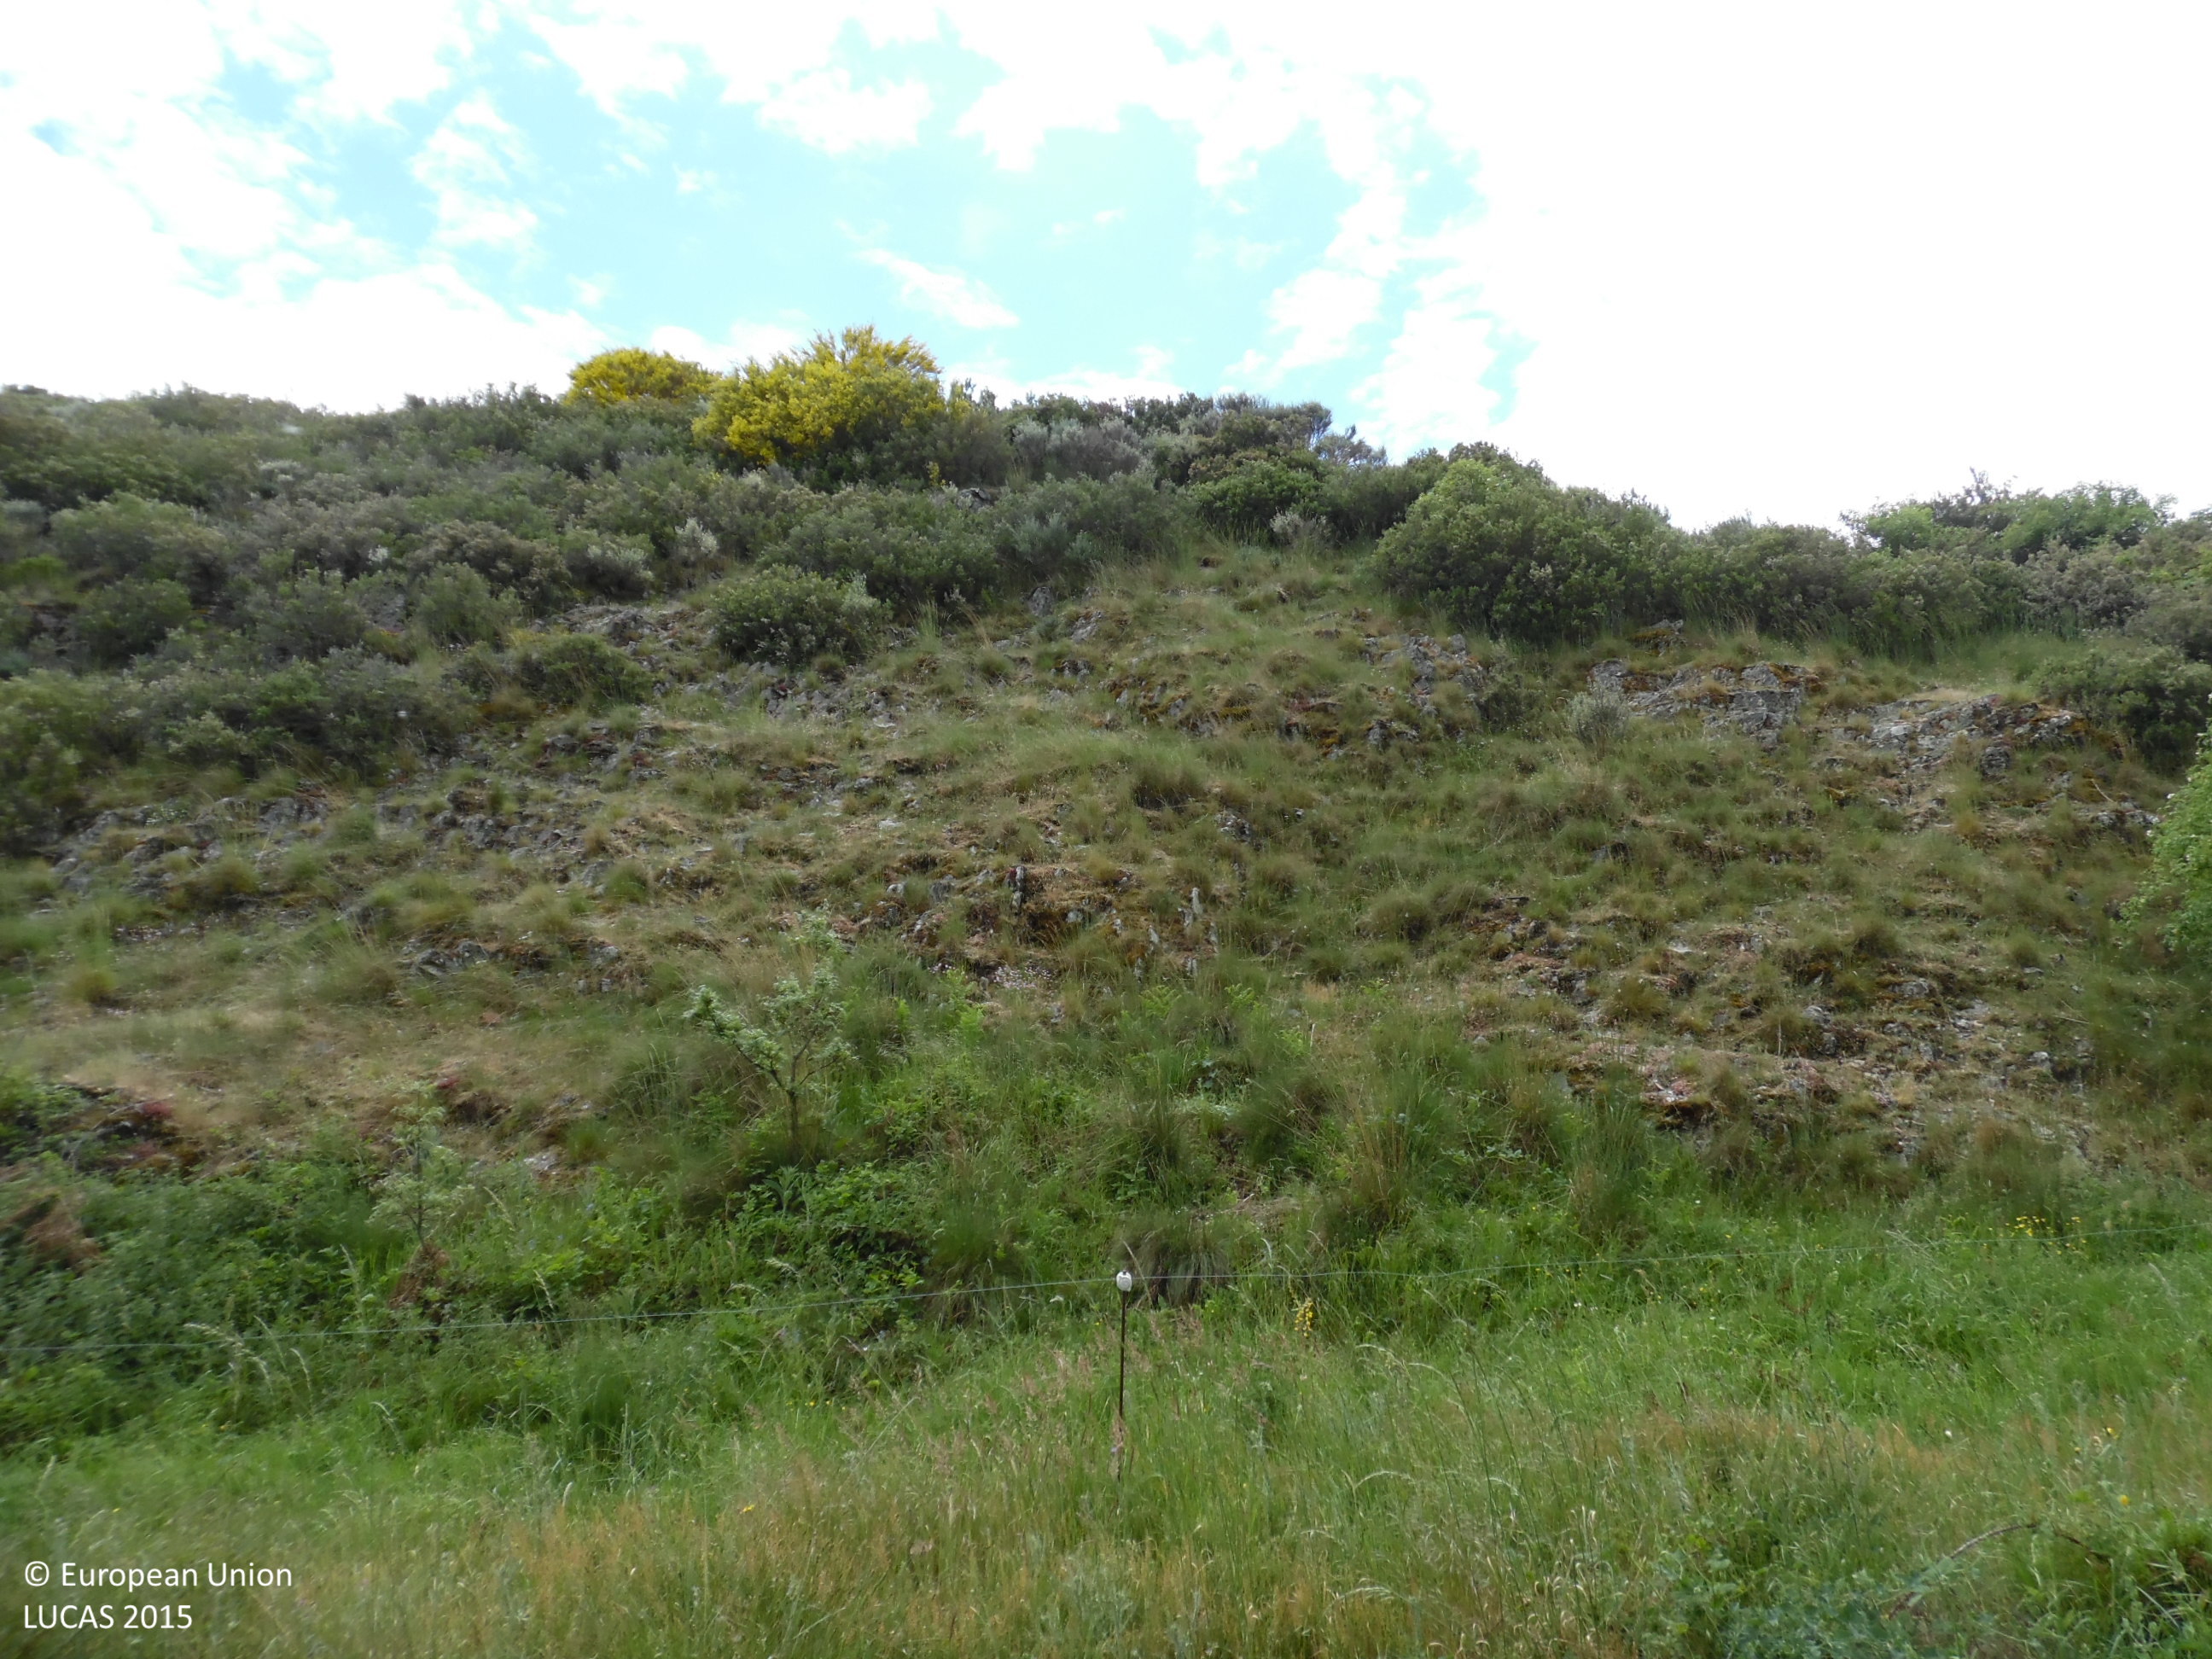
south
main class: Shrubland
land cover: Shrubland with sparse tree cover
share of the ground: > 75 %
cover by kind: shrubs 95 %, broadleaved forest trees 5 %
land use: Semi-natural and natural areas not in use
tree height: > 5 m
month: May
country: ES
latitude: 42.4556
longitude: -6.3459
